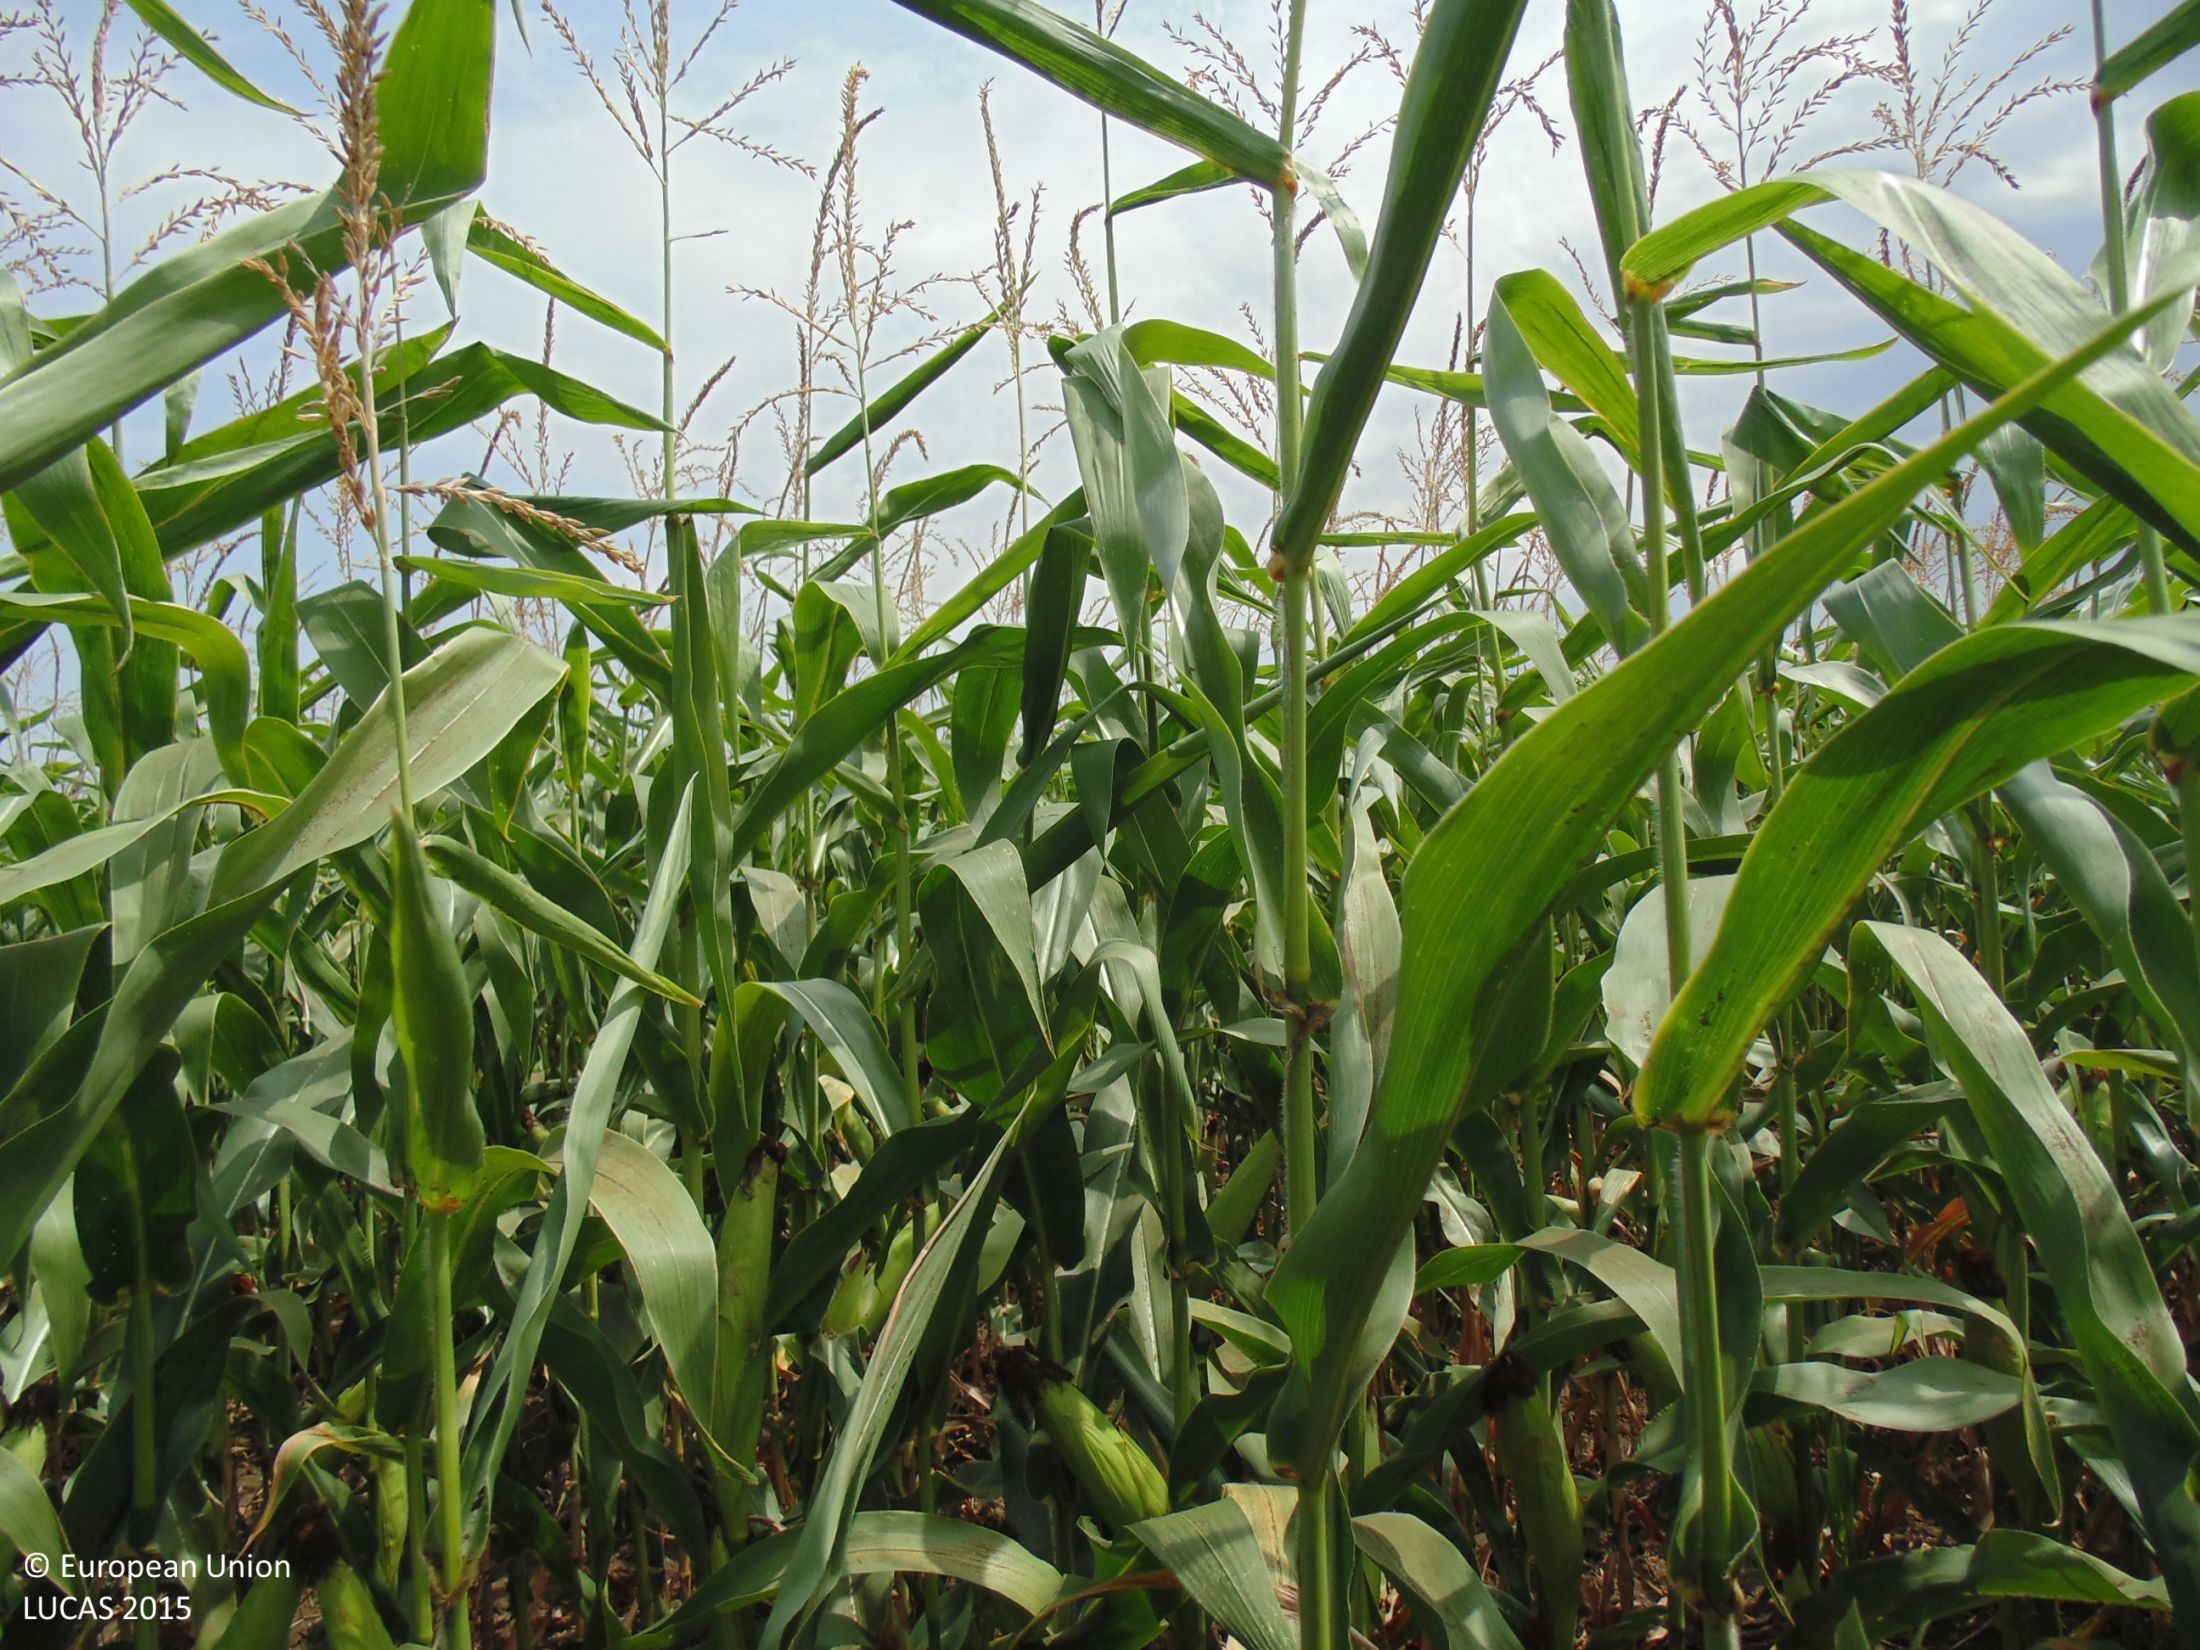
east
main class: Cropland
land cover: Maize
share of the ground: > 75 %
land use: Agriculture (excluding fallow land and kitchen gardens)
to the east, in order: Maize; Grass margins; Maize
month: August
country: BG
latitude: 43.7661
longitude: 28.1534
